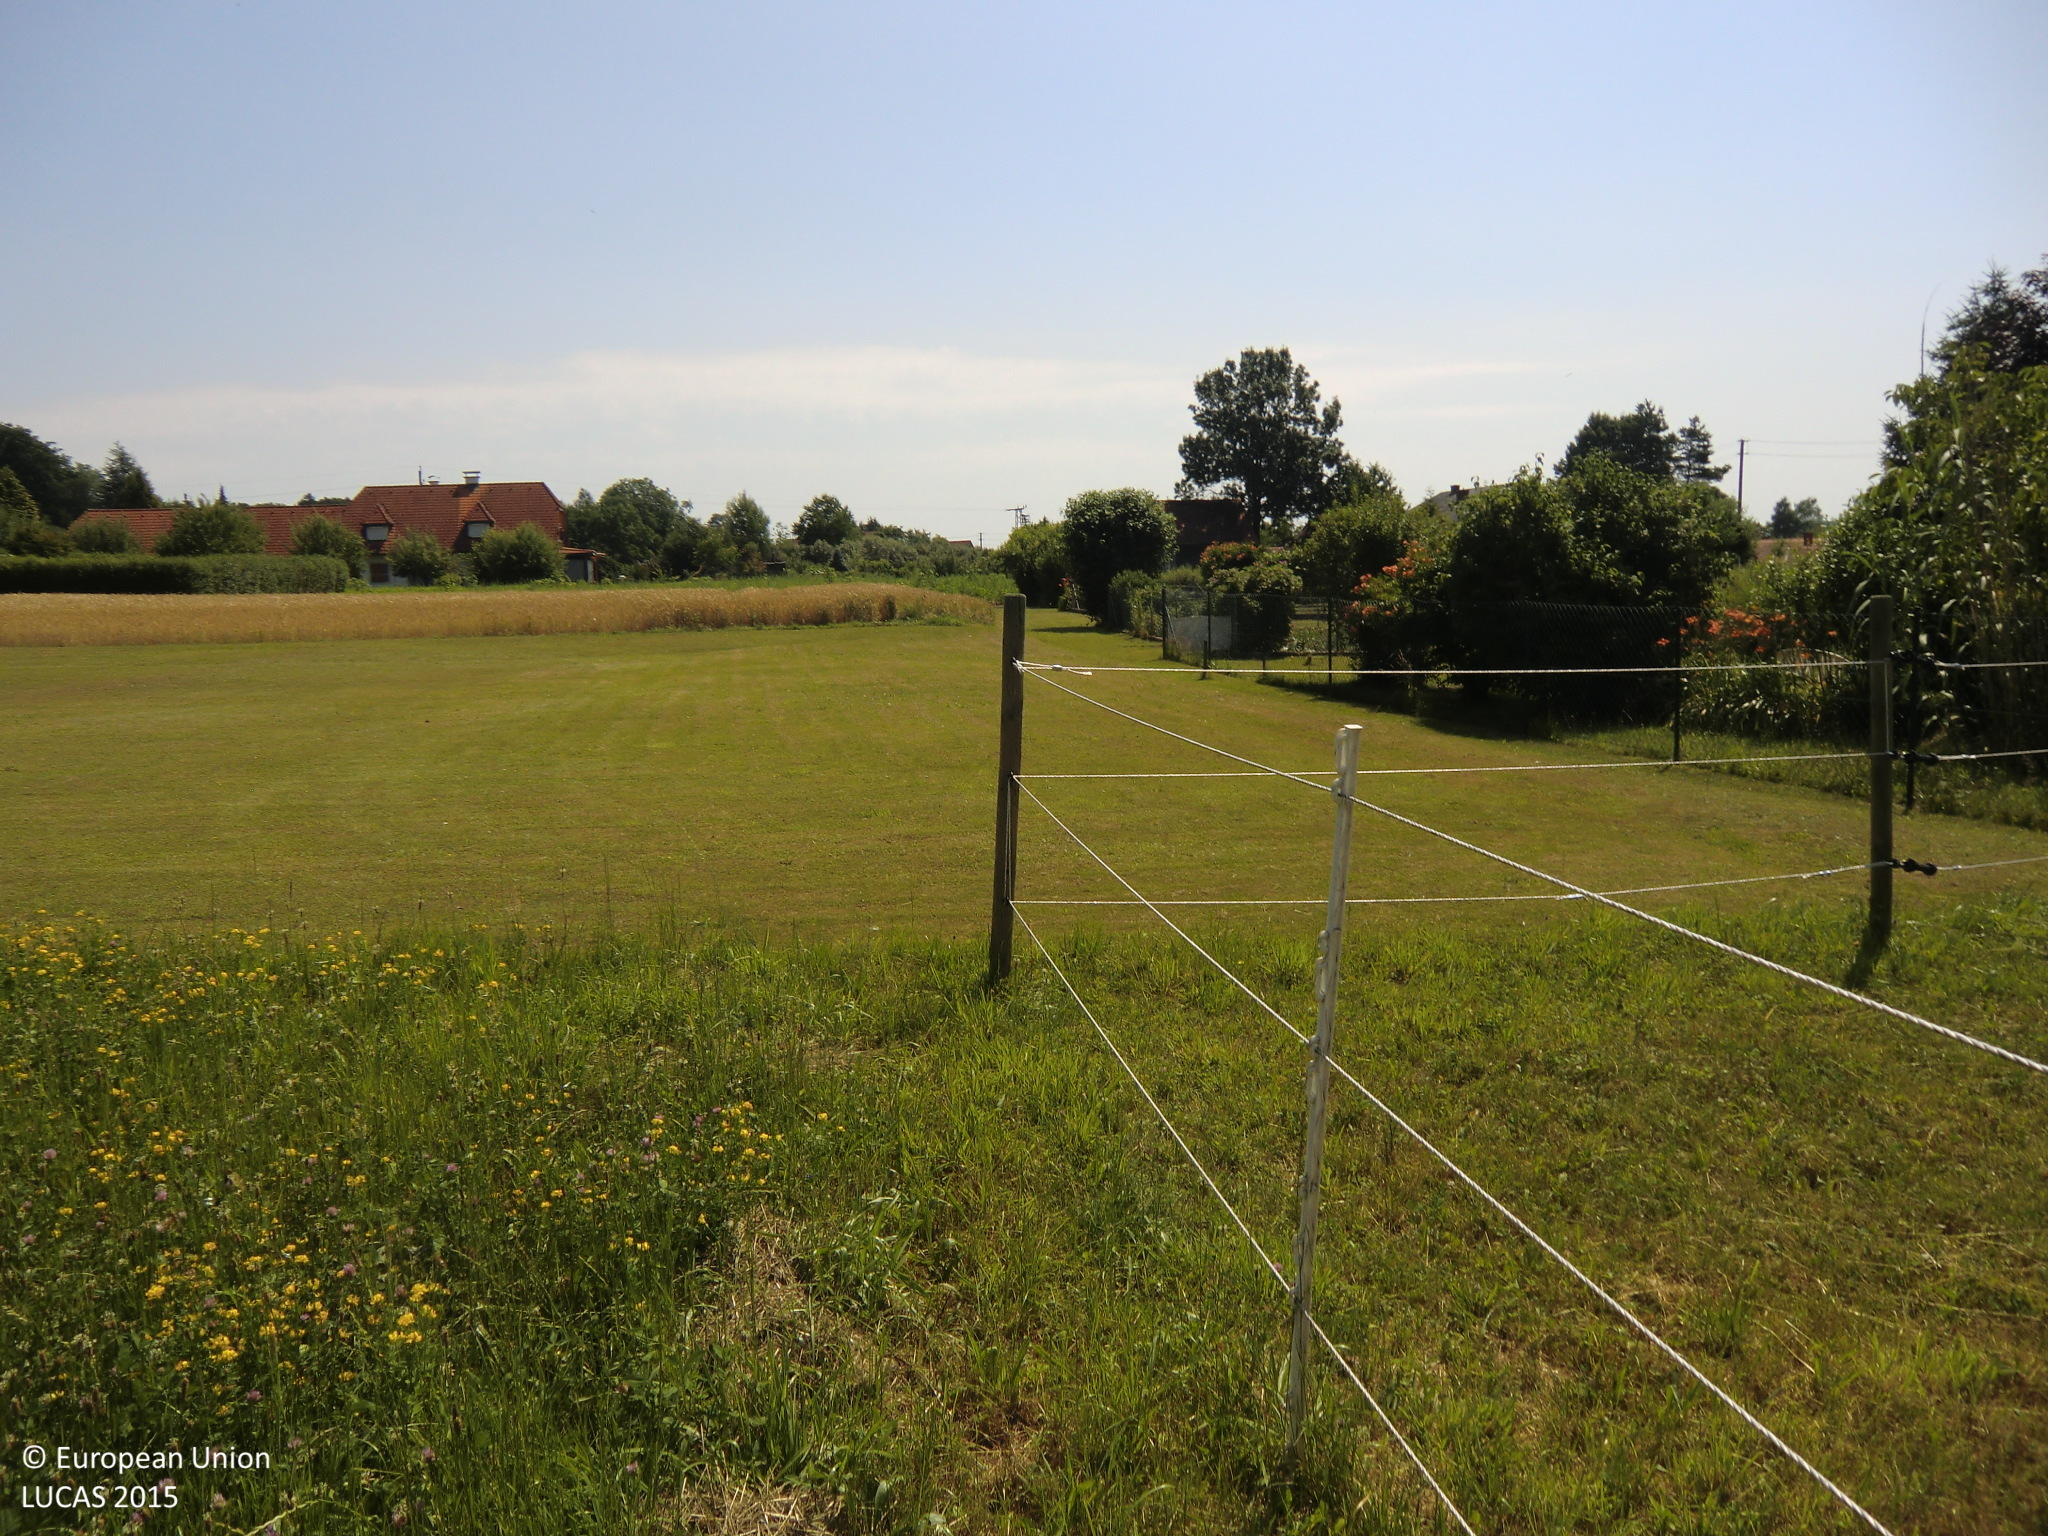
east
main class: Grassland
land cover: Grassland with sparse tree/shrub cover
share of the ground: > 75 %
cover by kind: herbaceous plants 95 %, coniferous forest trees 5 %
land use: Residential
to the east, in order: Grassland with sparse tree/shrub cover; Artificial constructions in urban areas; Other fibre and oleaginous crops; Artificial constructions in urban areas; Apple fruit; Grassland without tree/shrub cover; Fences; Paved roads, cycling and walking lanes; Shrubland with sparse tree cover; Grassland without tree/shrub cover; Electric lines; Grassland with sparse tree/shrub cover; Artificial constructions in urban areas
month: July
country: AT
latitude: 47.0887
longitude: 15.9421
